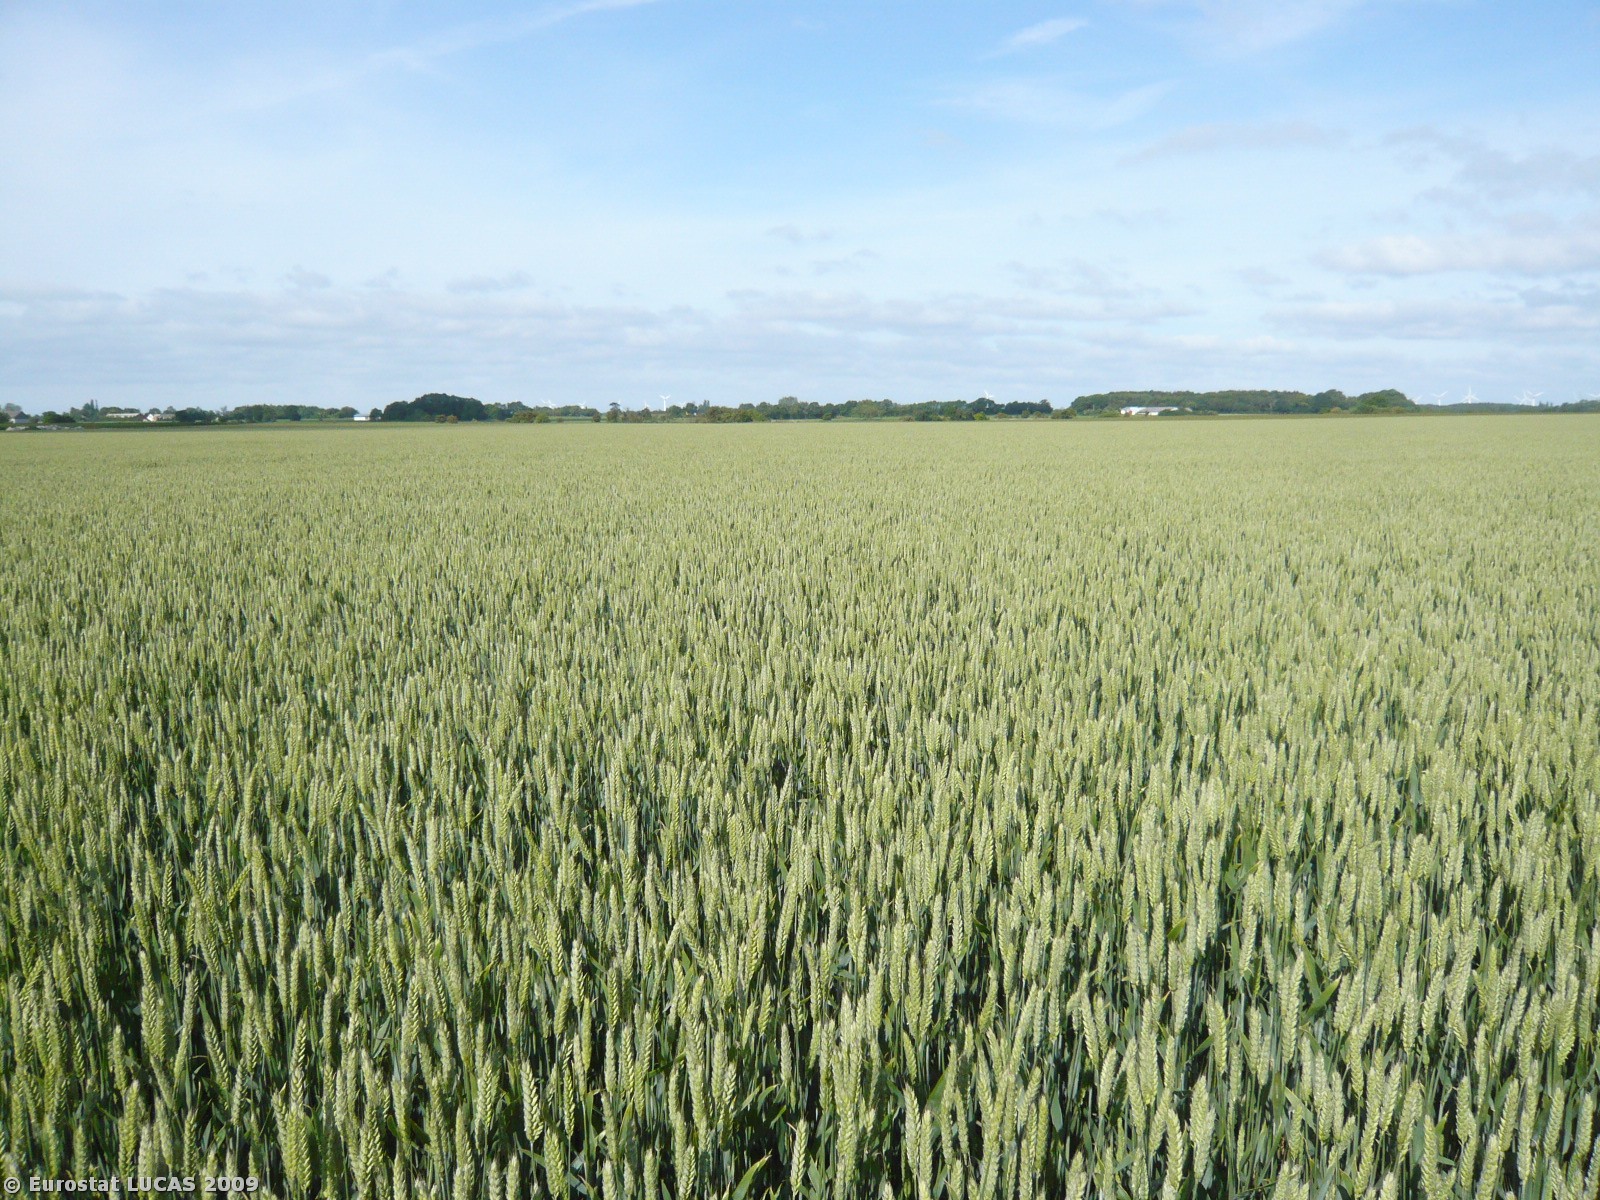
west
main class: Cropland
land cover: Common wheat
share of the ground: > 75 %
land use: Agriculture (excluding fallow land and kitchen gardens)
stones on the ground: < 10 %
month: June
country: DK
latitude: 54.9244
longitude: 11.1382
